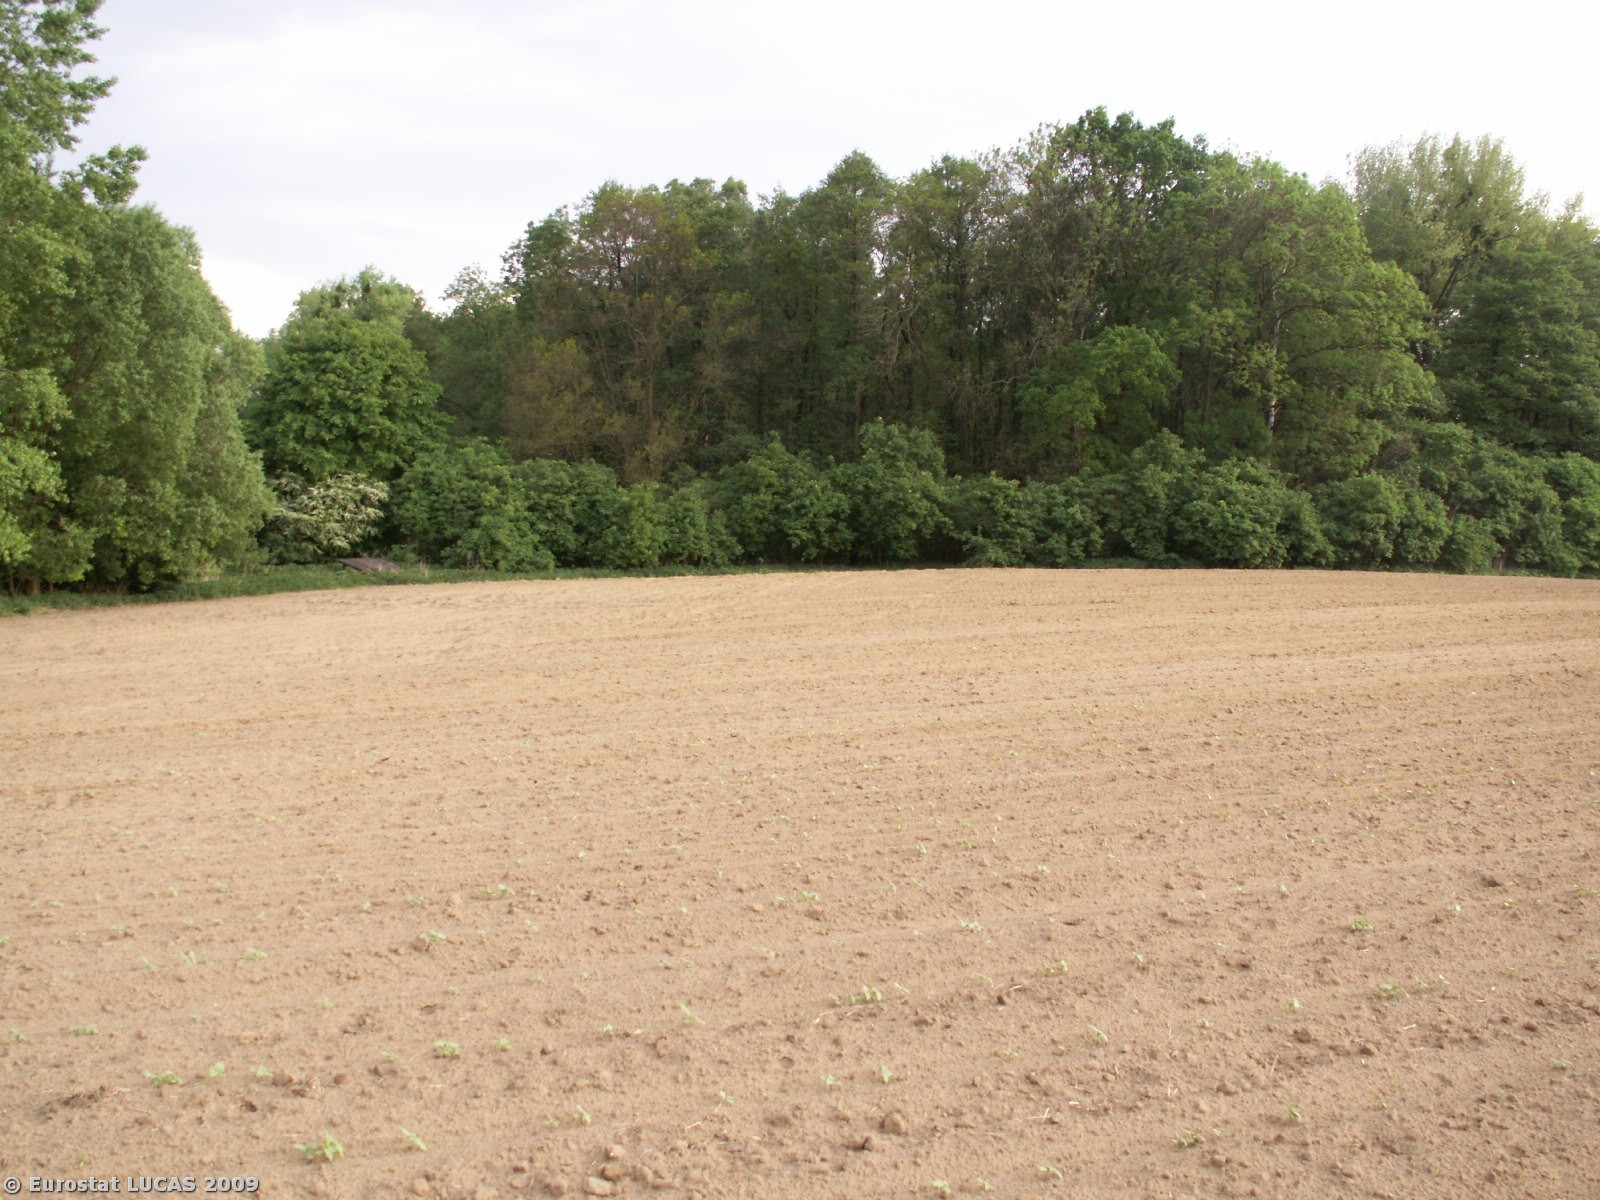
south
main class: Cropland
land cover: Sunflower
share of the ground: < 10 %
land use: Agriculture (excluding fallow land and kitchen gardens)
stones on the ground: < 10 %
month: May
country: CZ
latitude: 48.9663
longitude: 17.1536
